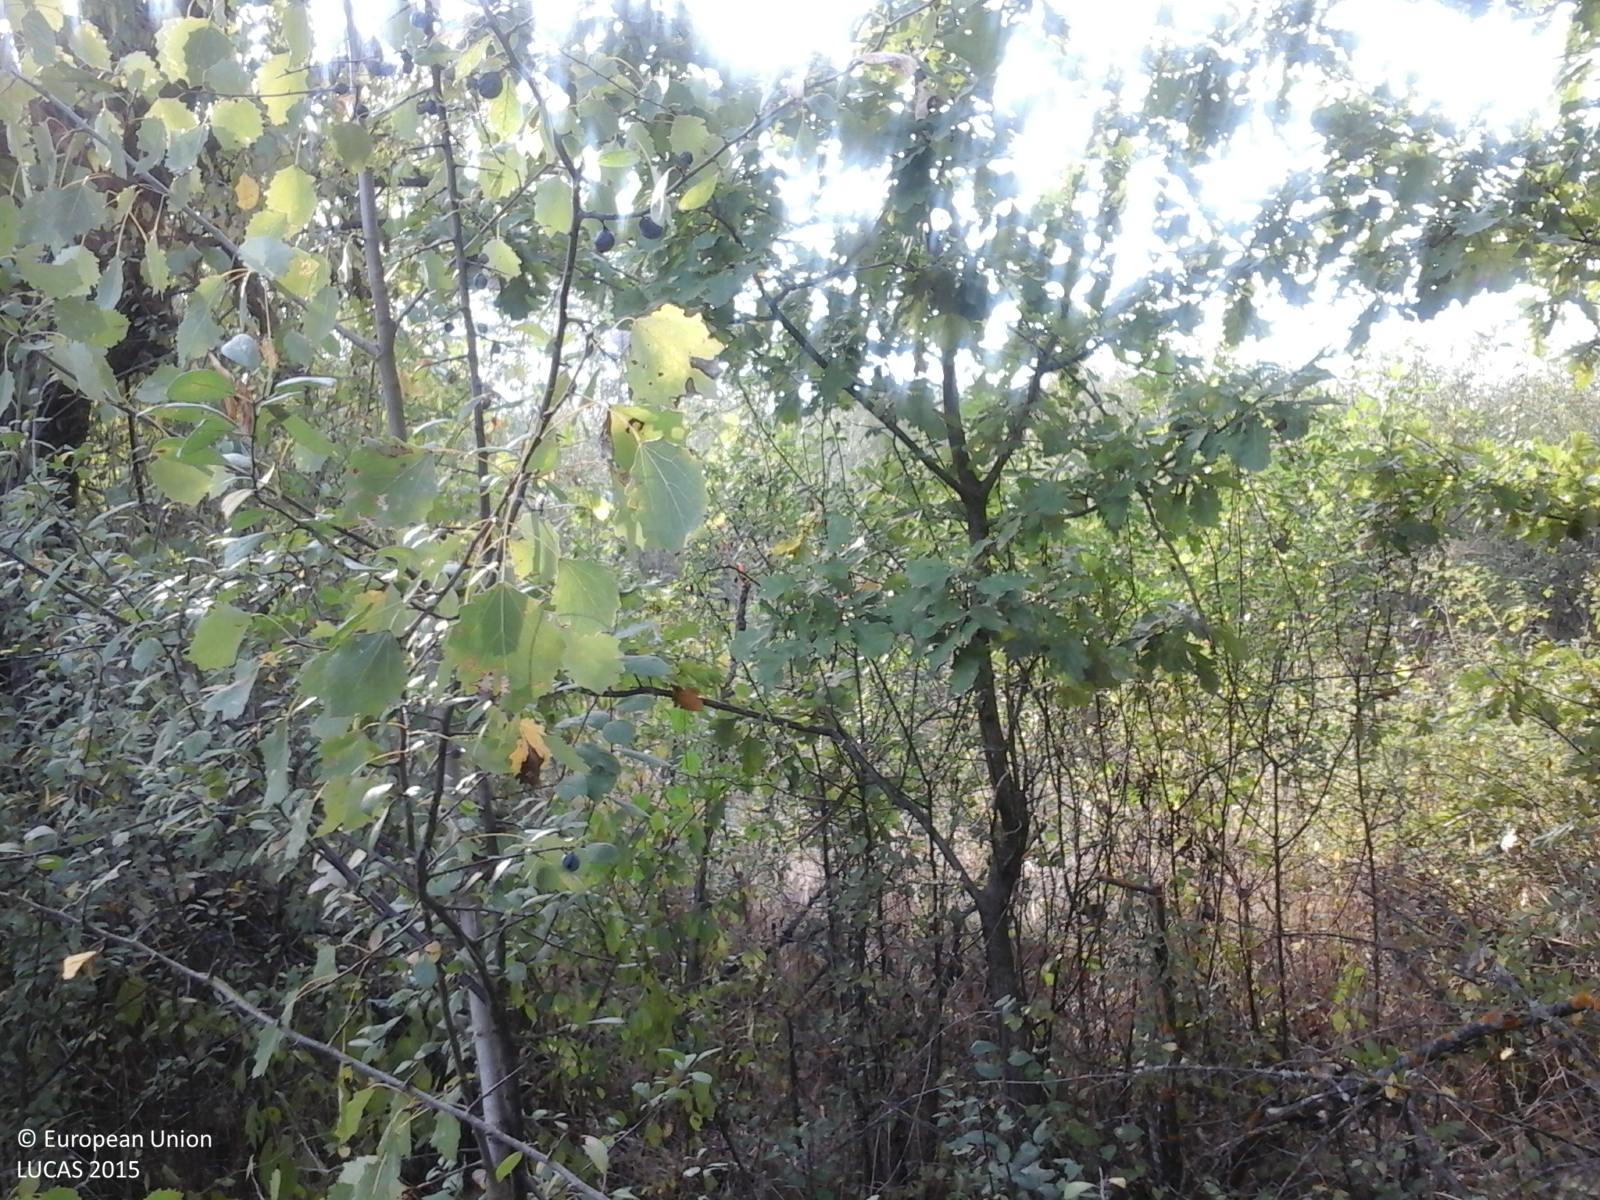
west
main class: Woodland
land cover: Broadleaved woodland
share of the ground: > 75 %
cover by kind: broadleaved forest trees 100 %
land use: Forestry
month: September
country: RO
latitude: 45.5087
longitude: 22.3177
